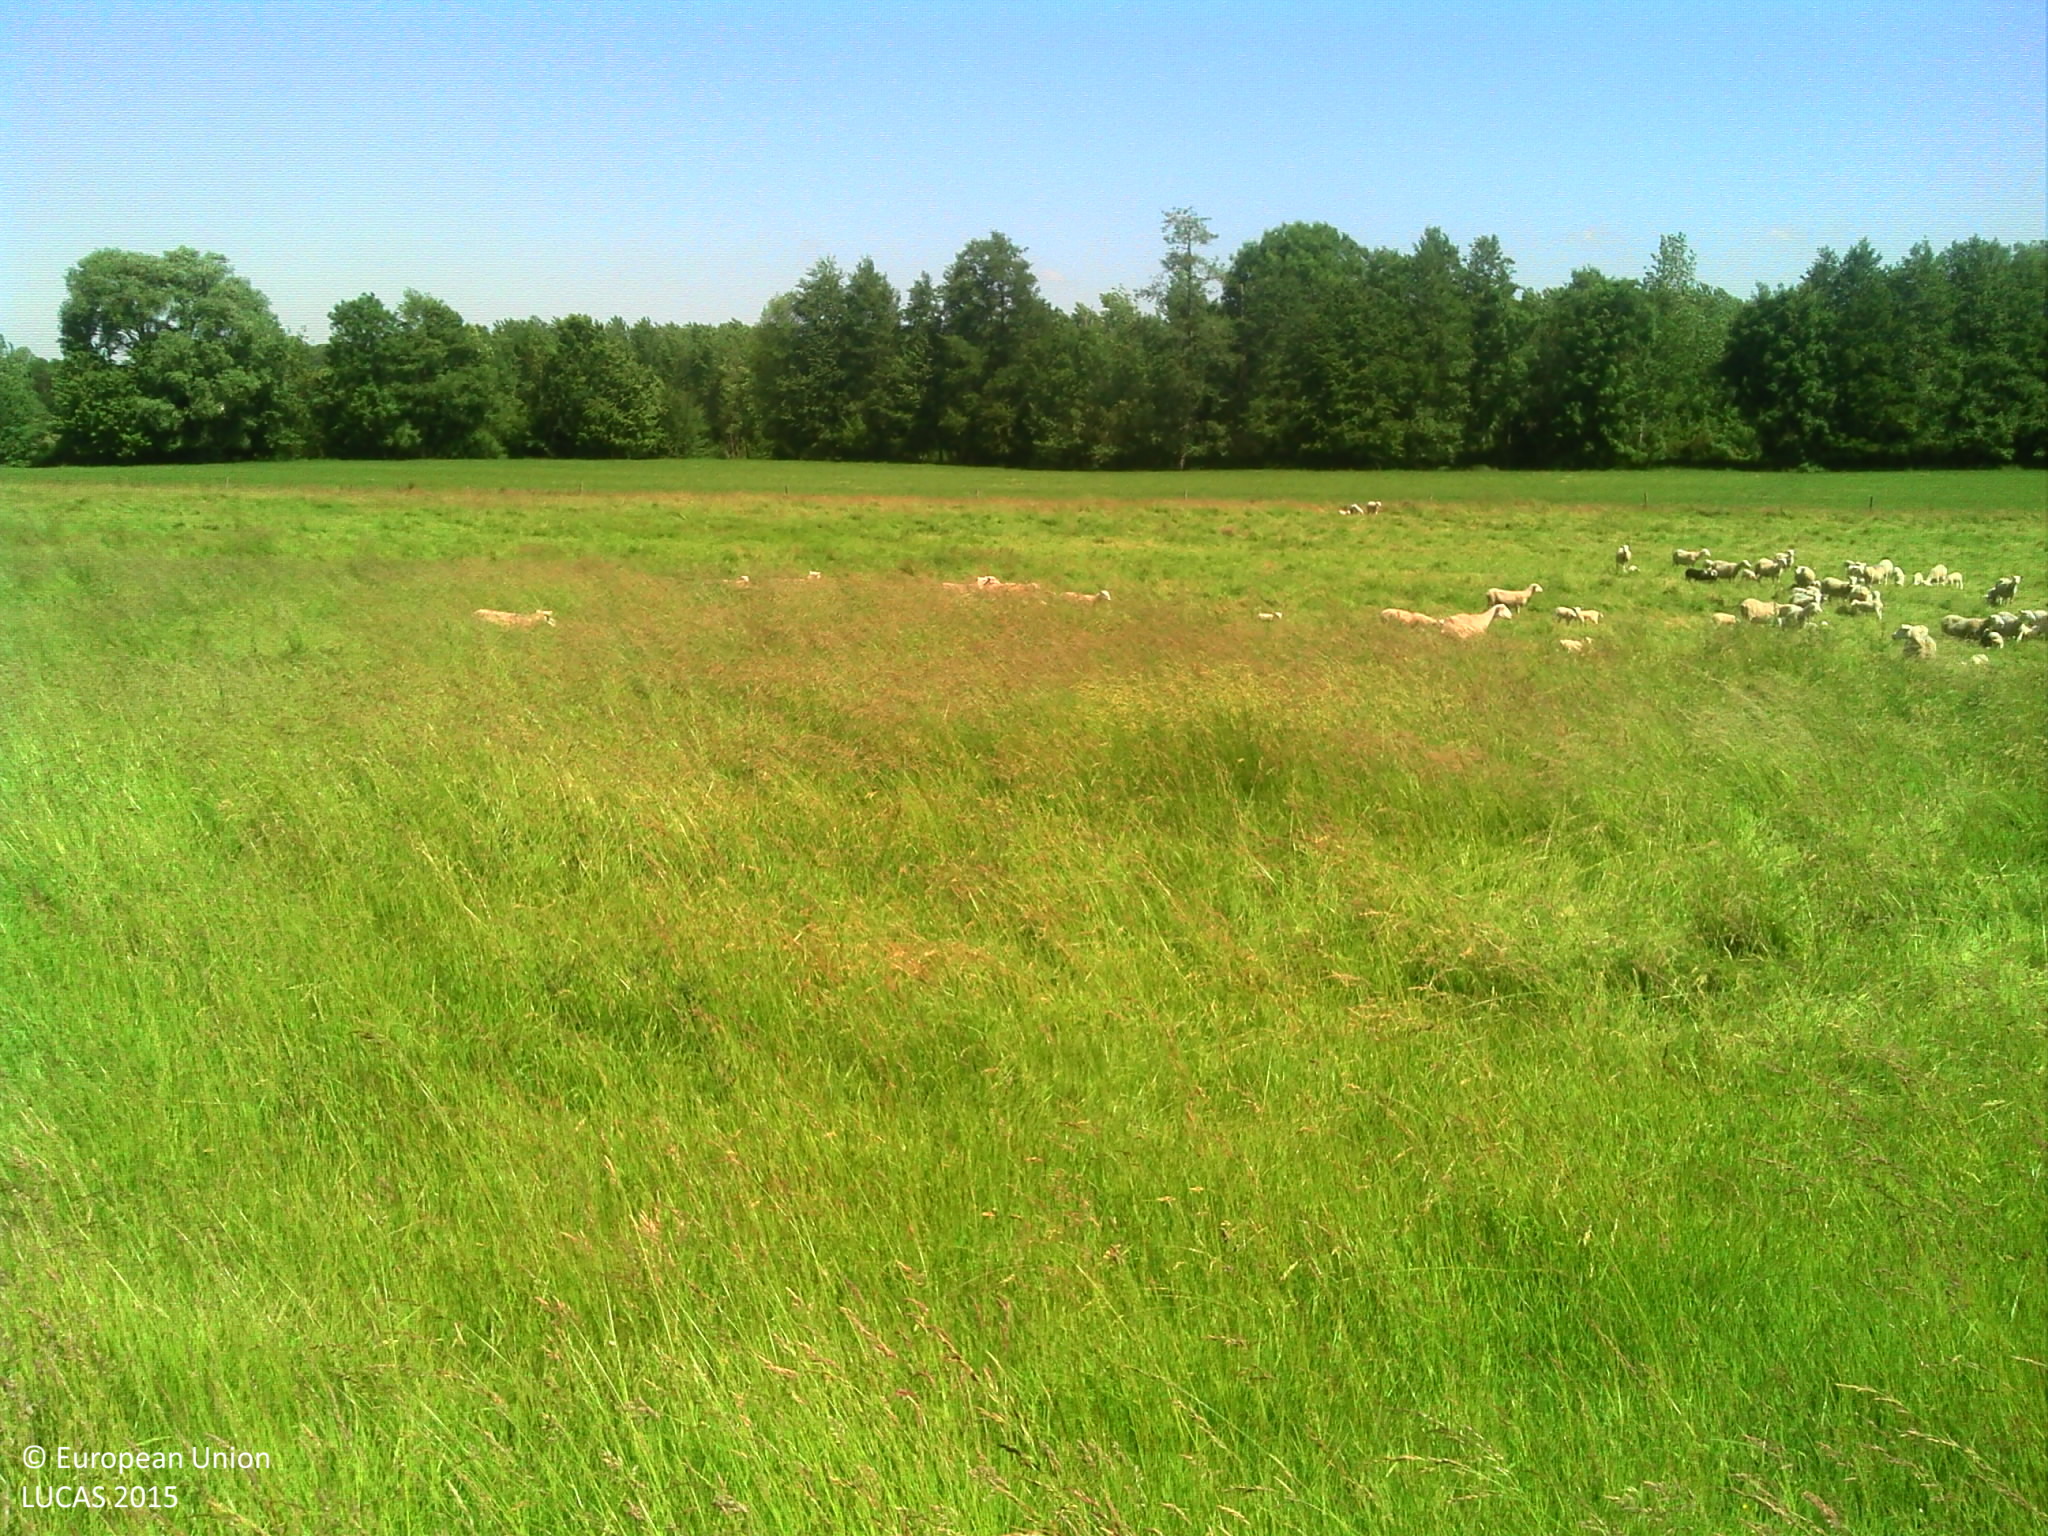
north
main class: Grassland
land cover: Grassland without tree/shrub cover
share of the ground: > 75 %
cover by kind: herbaceous plants 100 %
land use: Agriculture (excluding fallow land and kitchen gardens)
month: June
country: FR
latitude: 49.6697
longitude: 4.0783
